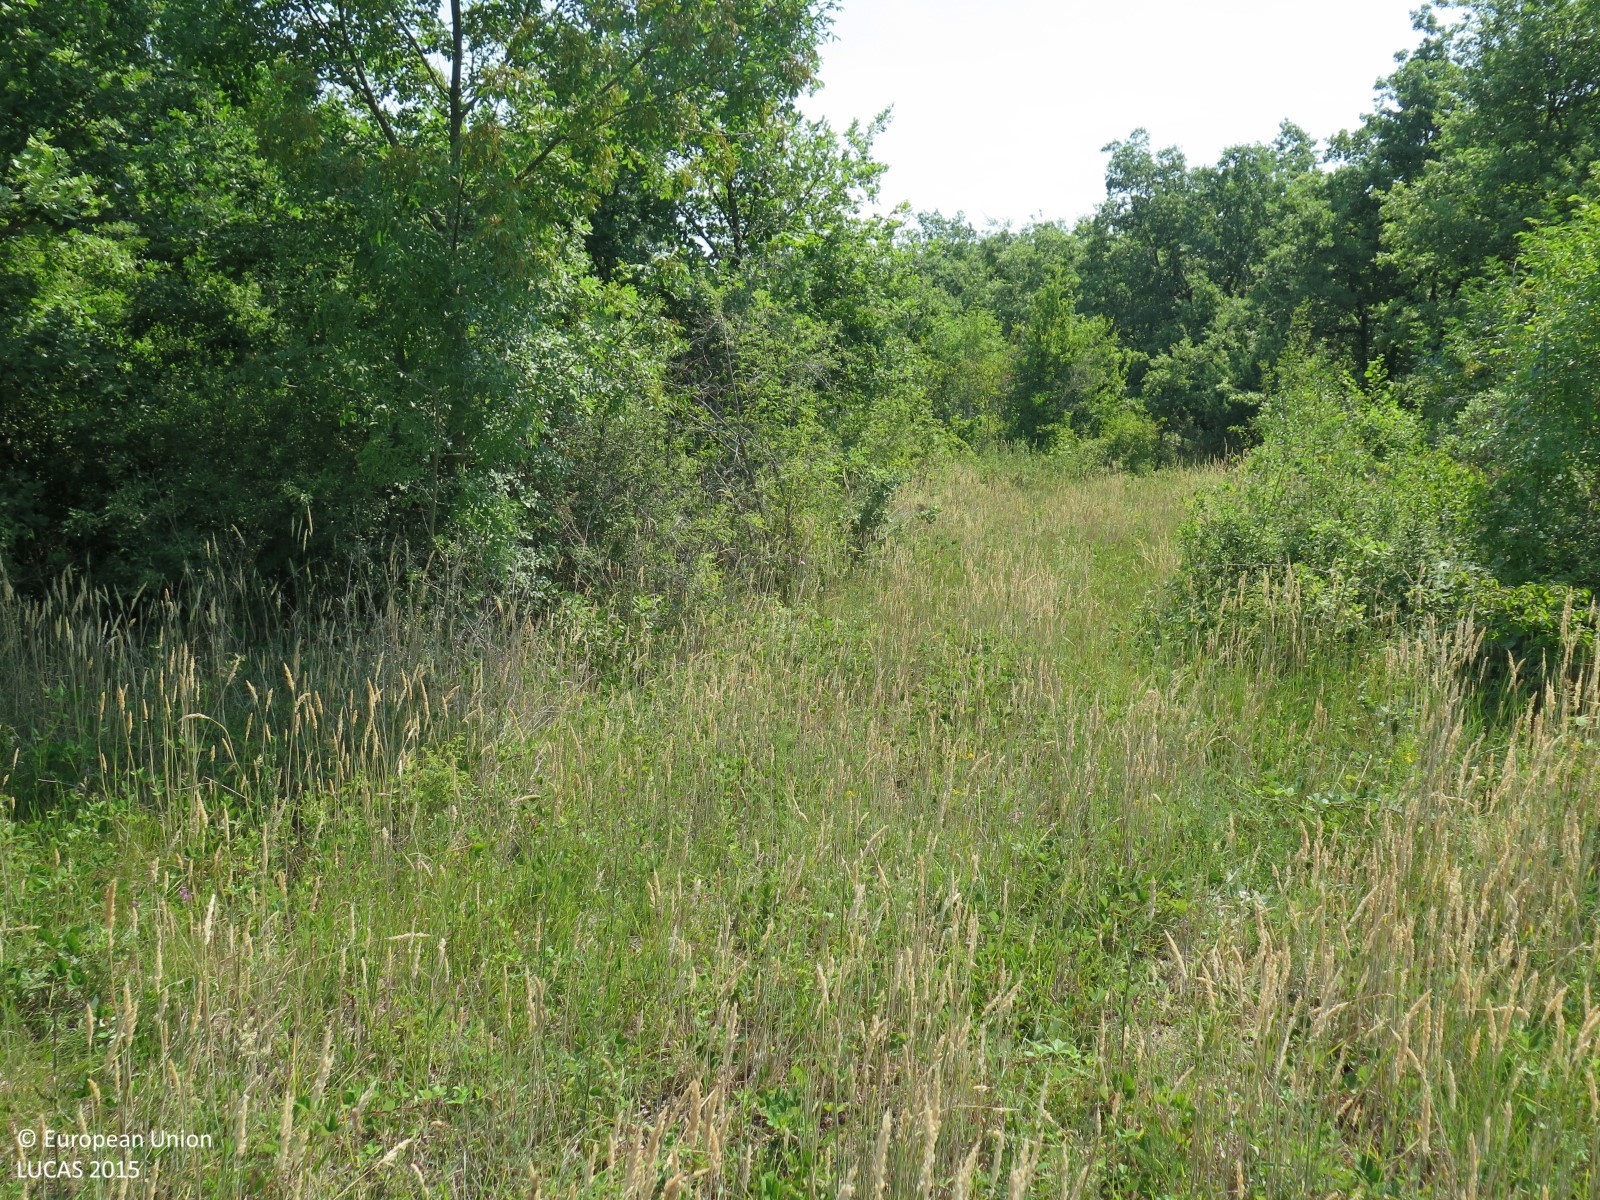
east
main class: Grassland
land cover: Grassland with sparse tree/shrub cover
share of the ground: > 75 %
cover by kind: herbaceous plants 90 %, broadleaved forest trees 5 %, shrubs 5 %
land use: Semi-natural and natural areas not in use
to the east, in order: Grassland with sparse tree/shrub cover; Shrubland with sparse tree cover; Broadleaved woodland; Grassland with sparse tree/shrub cover; Broadleaved woodland; Shrubland with sparse tree cover
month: July
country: HR
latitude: 45.2788
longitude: 13.6536
